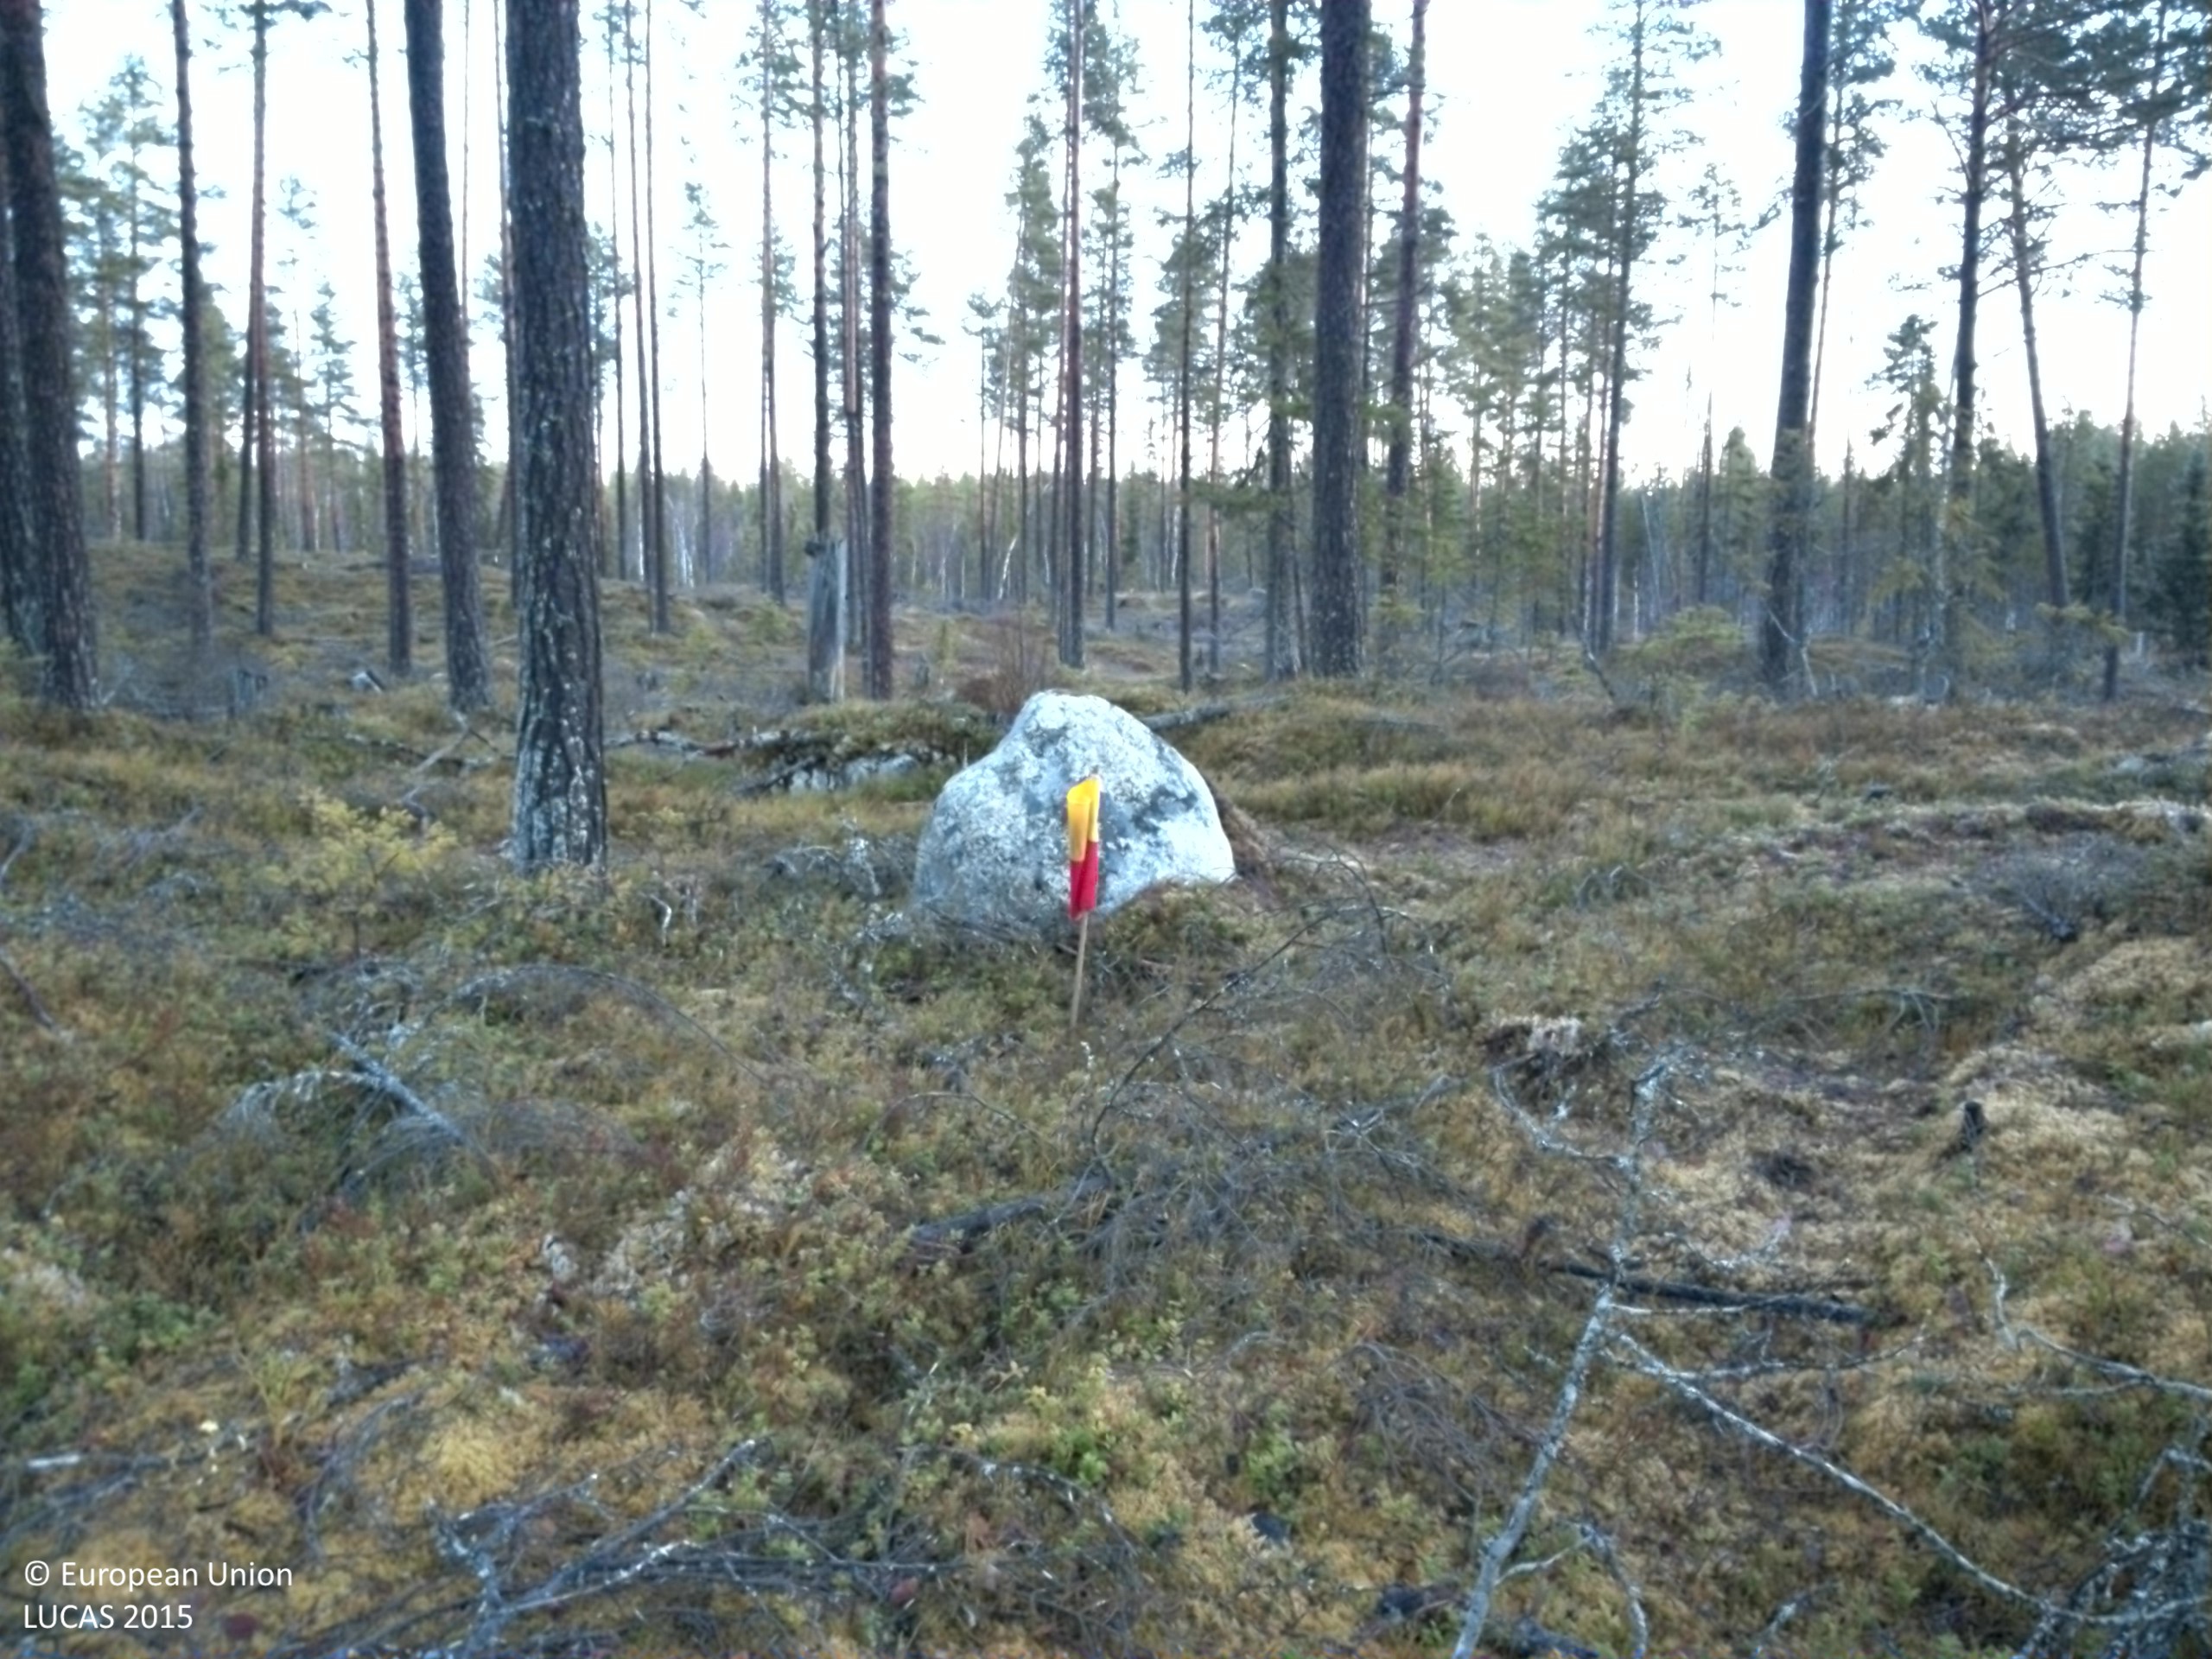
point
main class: Woodland
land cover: Pine dominated coniferous woodland
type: boreal forest
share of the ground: 25 - 50 %
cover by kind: shrubs 50 %, coniferous forest trees 25 %, lichens and mosses 20 %, broadleaved forest trees 5 %
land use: Forestry
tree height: > 5 m
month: November
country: SE
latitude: 63.8940
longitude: 16.2657
